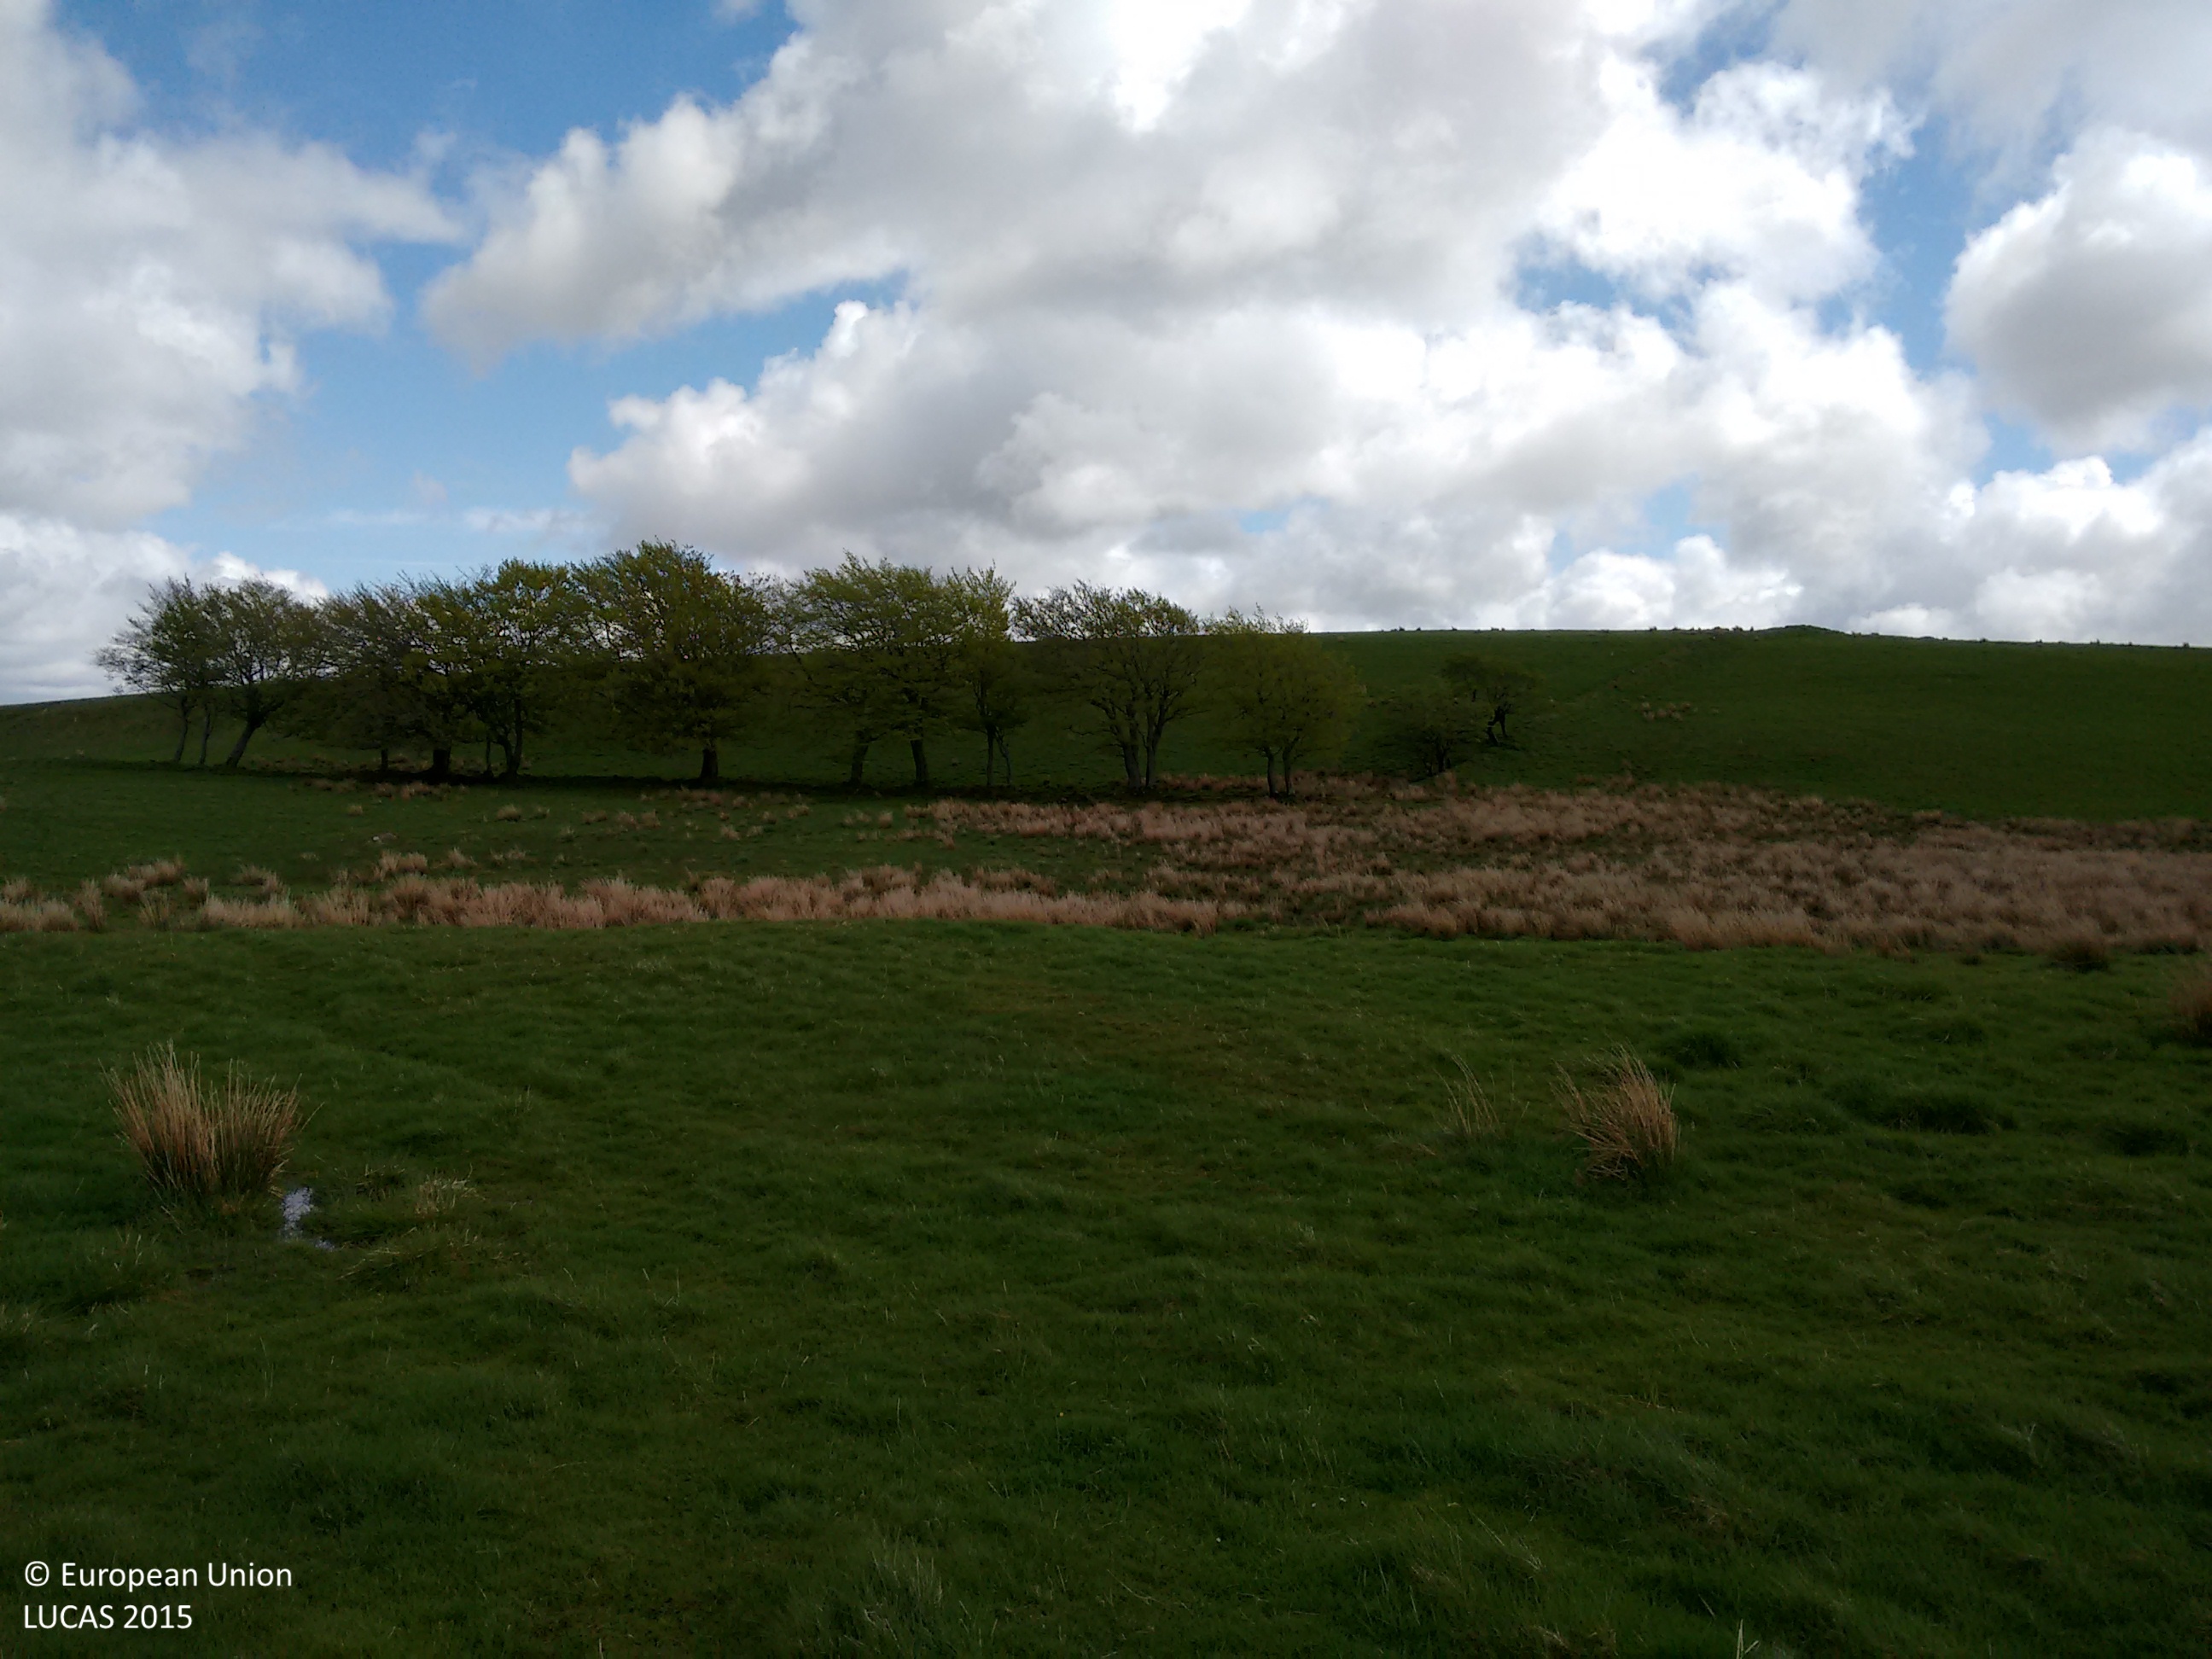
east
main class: Grassland
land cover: Grassland without tree/shrub cover
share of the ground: > 75 %
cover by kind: herbaceous plants 100 %
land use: Agriculture (excluding fallow land and kitchen gardens)
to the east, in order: Grassland without tree/shrub cover; Dry stone walls; Lines of trees; Grassland without tree/shrub cover
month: May
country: GB
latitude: 55.7478
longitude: -4.4519
